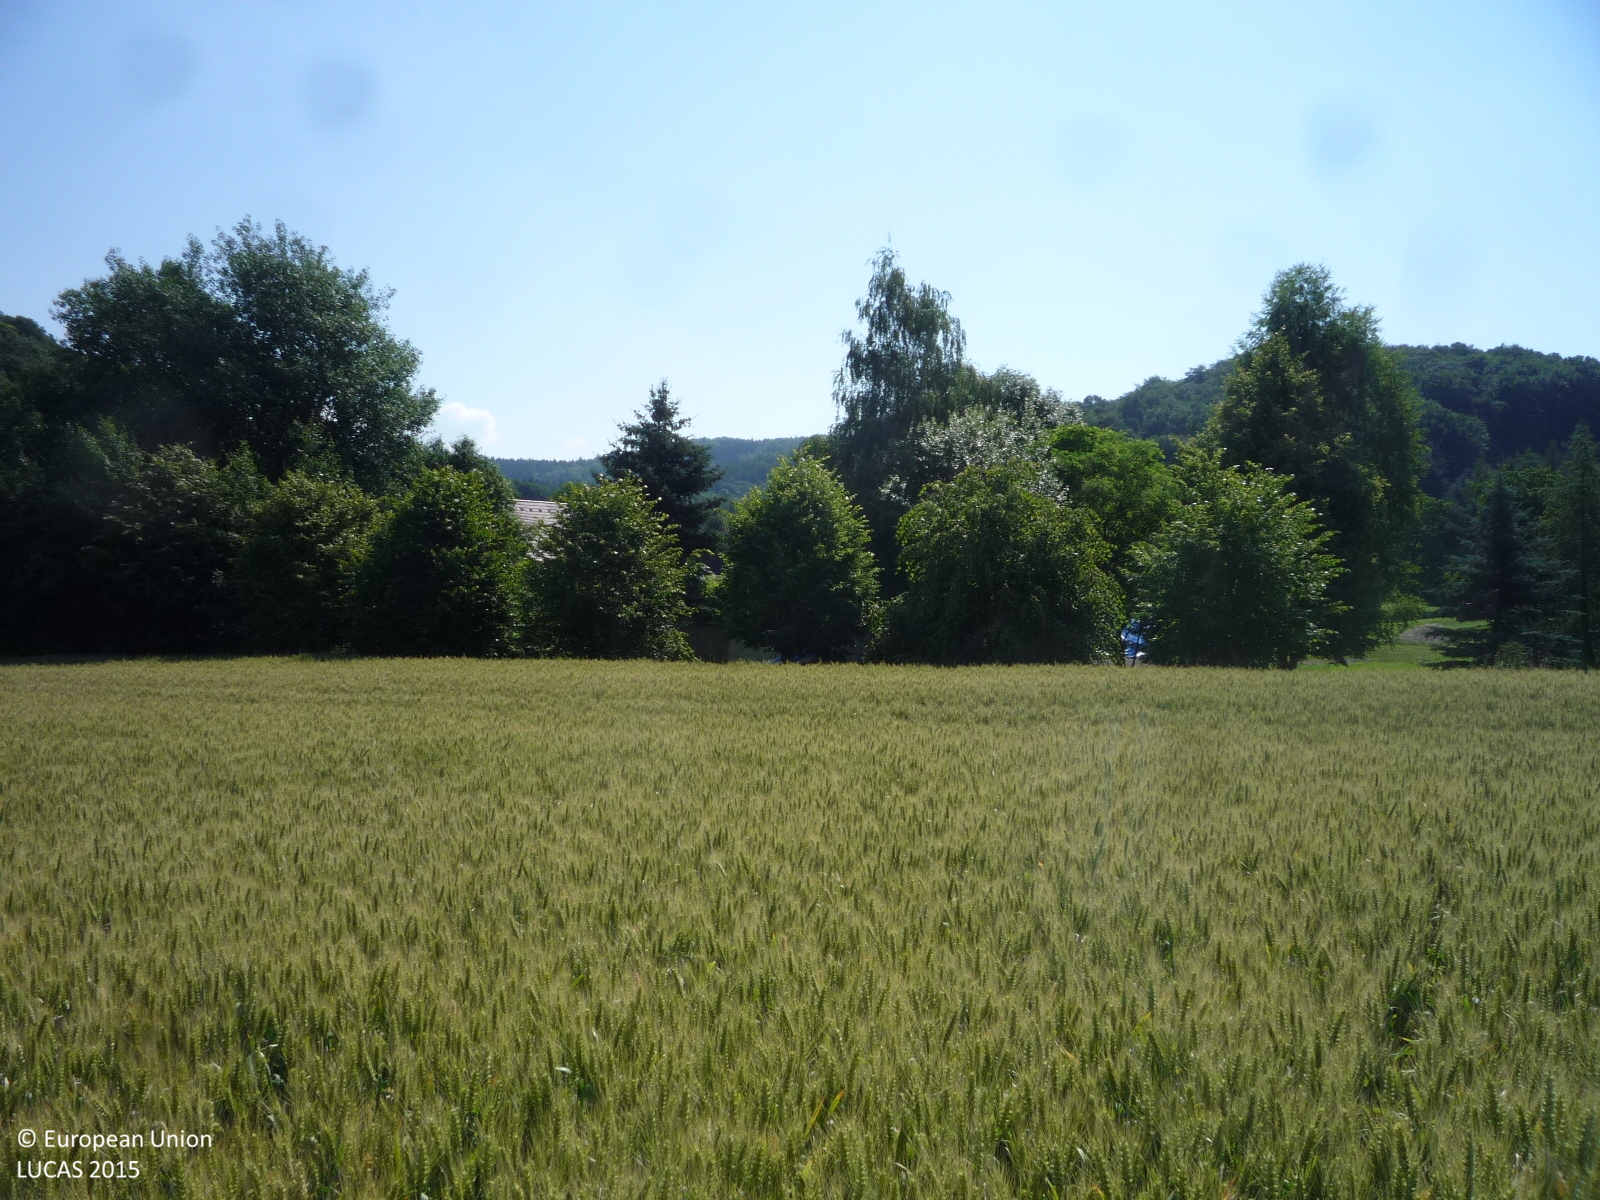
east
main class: Cropland
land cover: Common wheat
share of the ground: > 75 %
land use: Agriculture (excluding fallow land and kitchen gardens)
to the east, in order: Common wheat; Grass margins; Lines of trees; Grassland without tree/shrub cover; Artificial constructions in urban areas; Lines of trees; Grassland without tree/shrub cover
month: July
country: CZ
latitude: 50.5682
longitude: 13.8835
